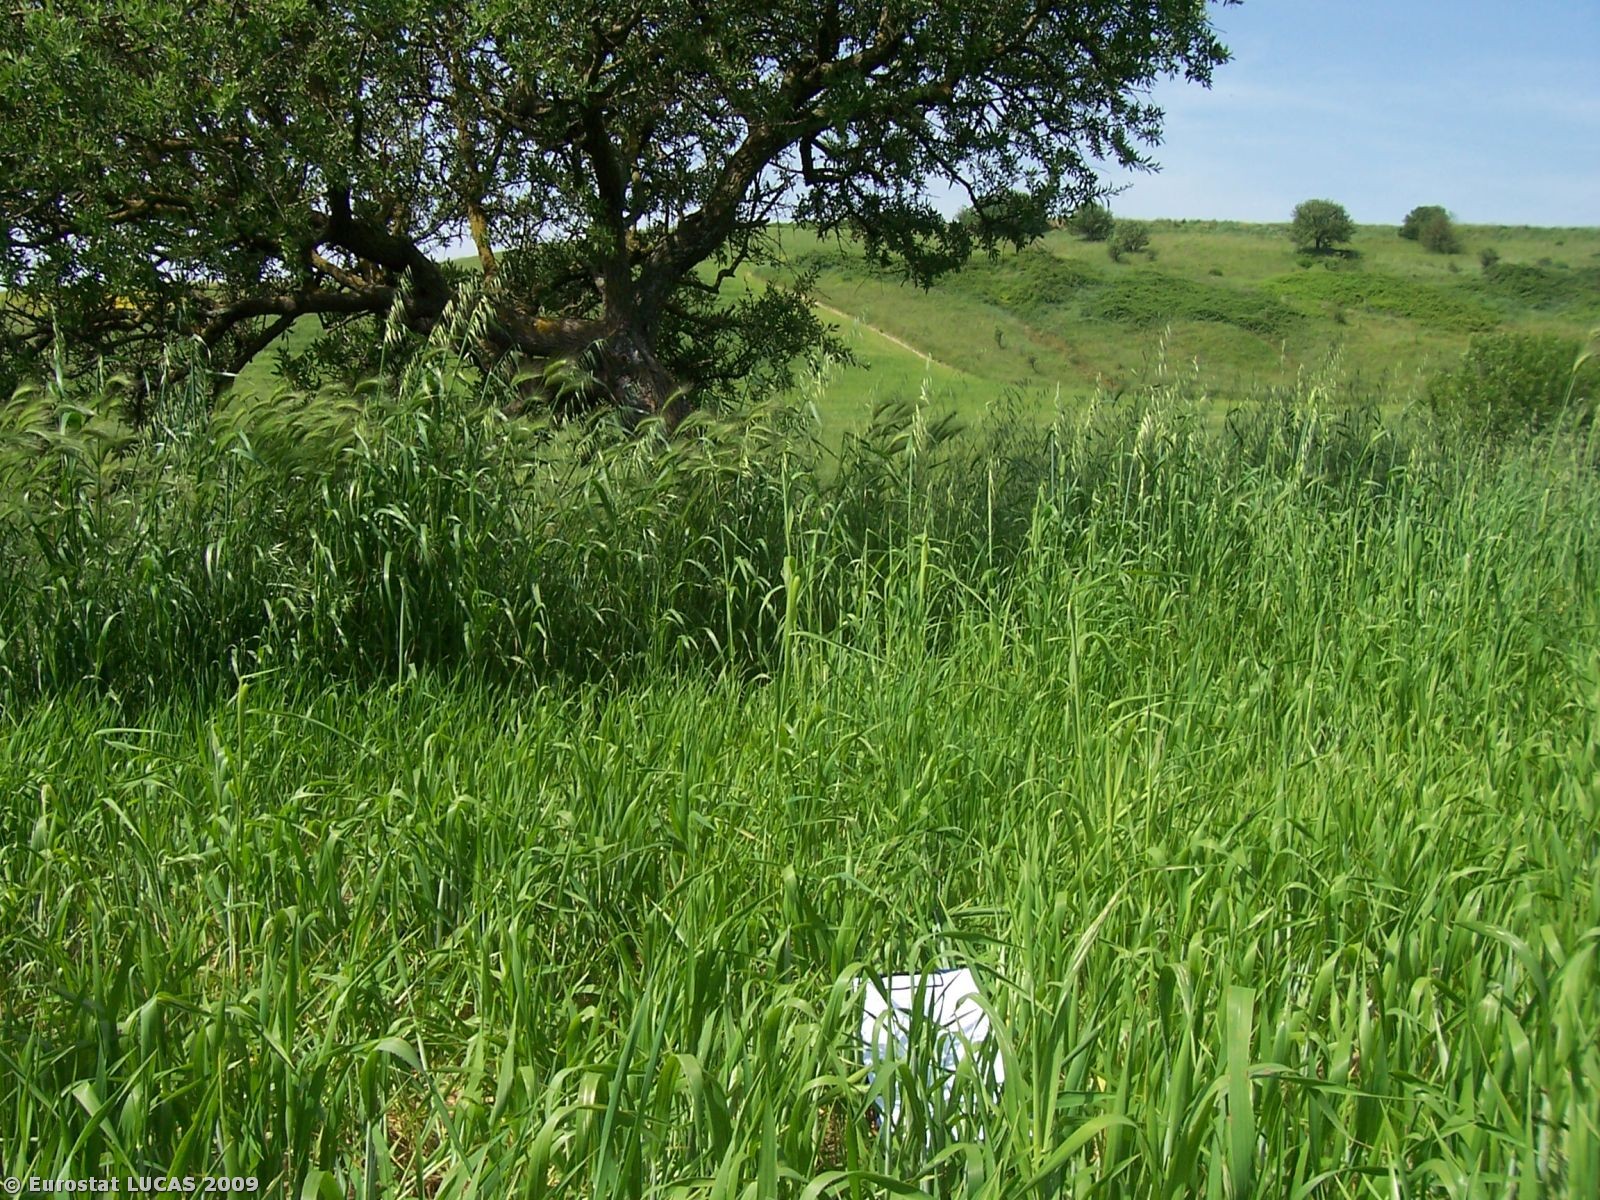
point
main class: Cropland
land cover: Durum wheat
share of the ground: > 75 %
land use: Agriculture (excluding fallow land and kitchen gardens)
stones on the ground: < 10 %
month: May
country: IT
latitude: 40.6631
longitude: 16.8491
